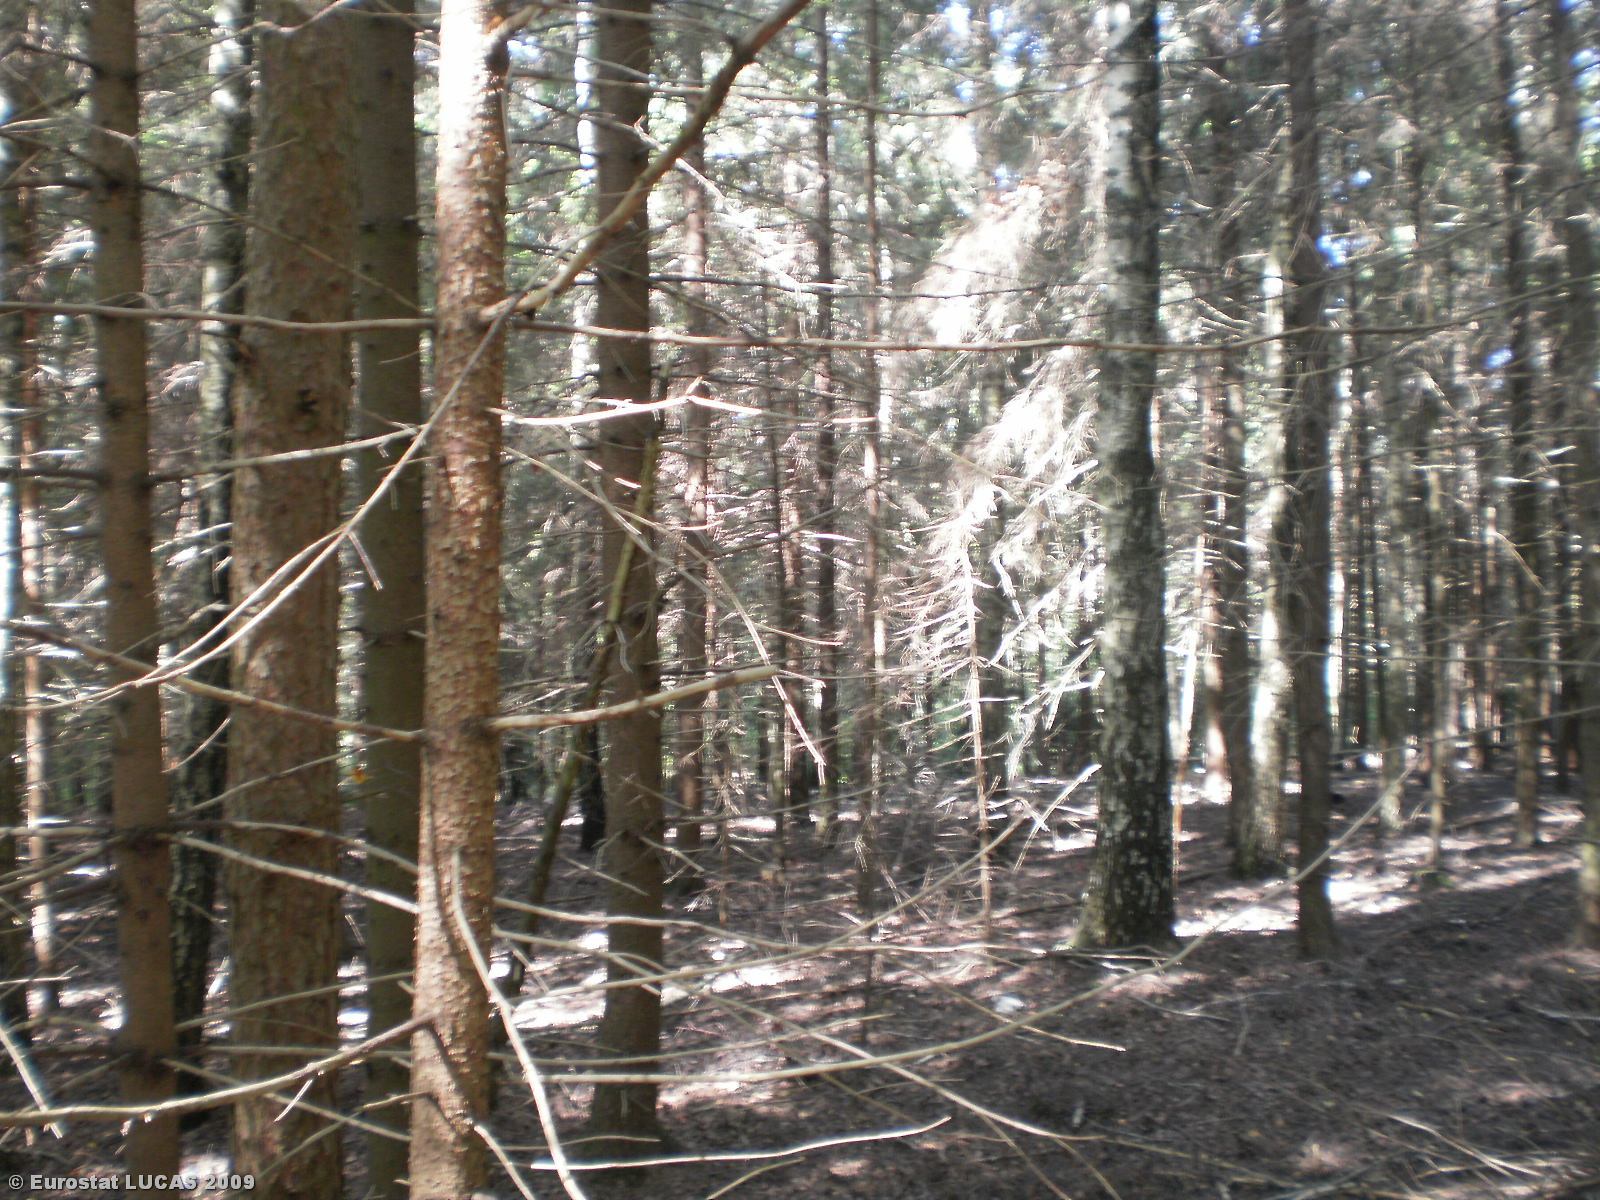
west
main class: Woodland
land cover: Coniferous woodland
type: hemiboreal forest and nemoral coniferous forest and mixed broadleaved-coniferous forest
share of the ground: > 75 %
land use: Forestry
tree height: > 5 m
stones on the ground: < 10 %
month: August
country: LT
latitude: 55.7507
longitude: 25.2037
